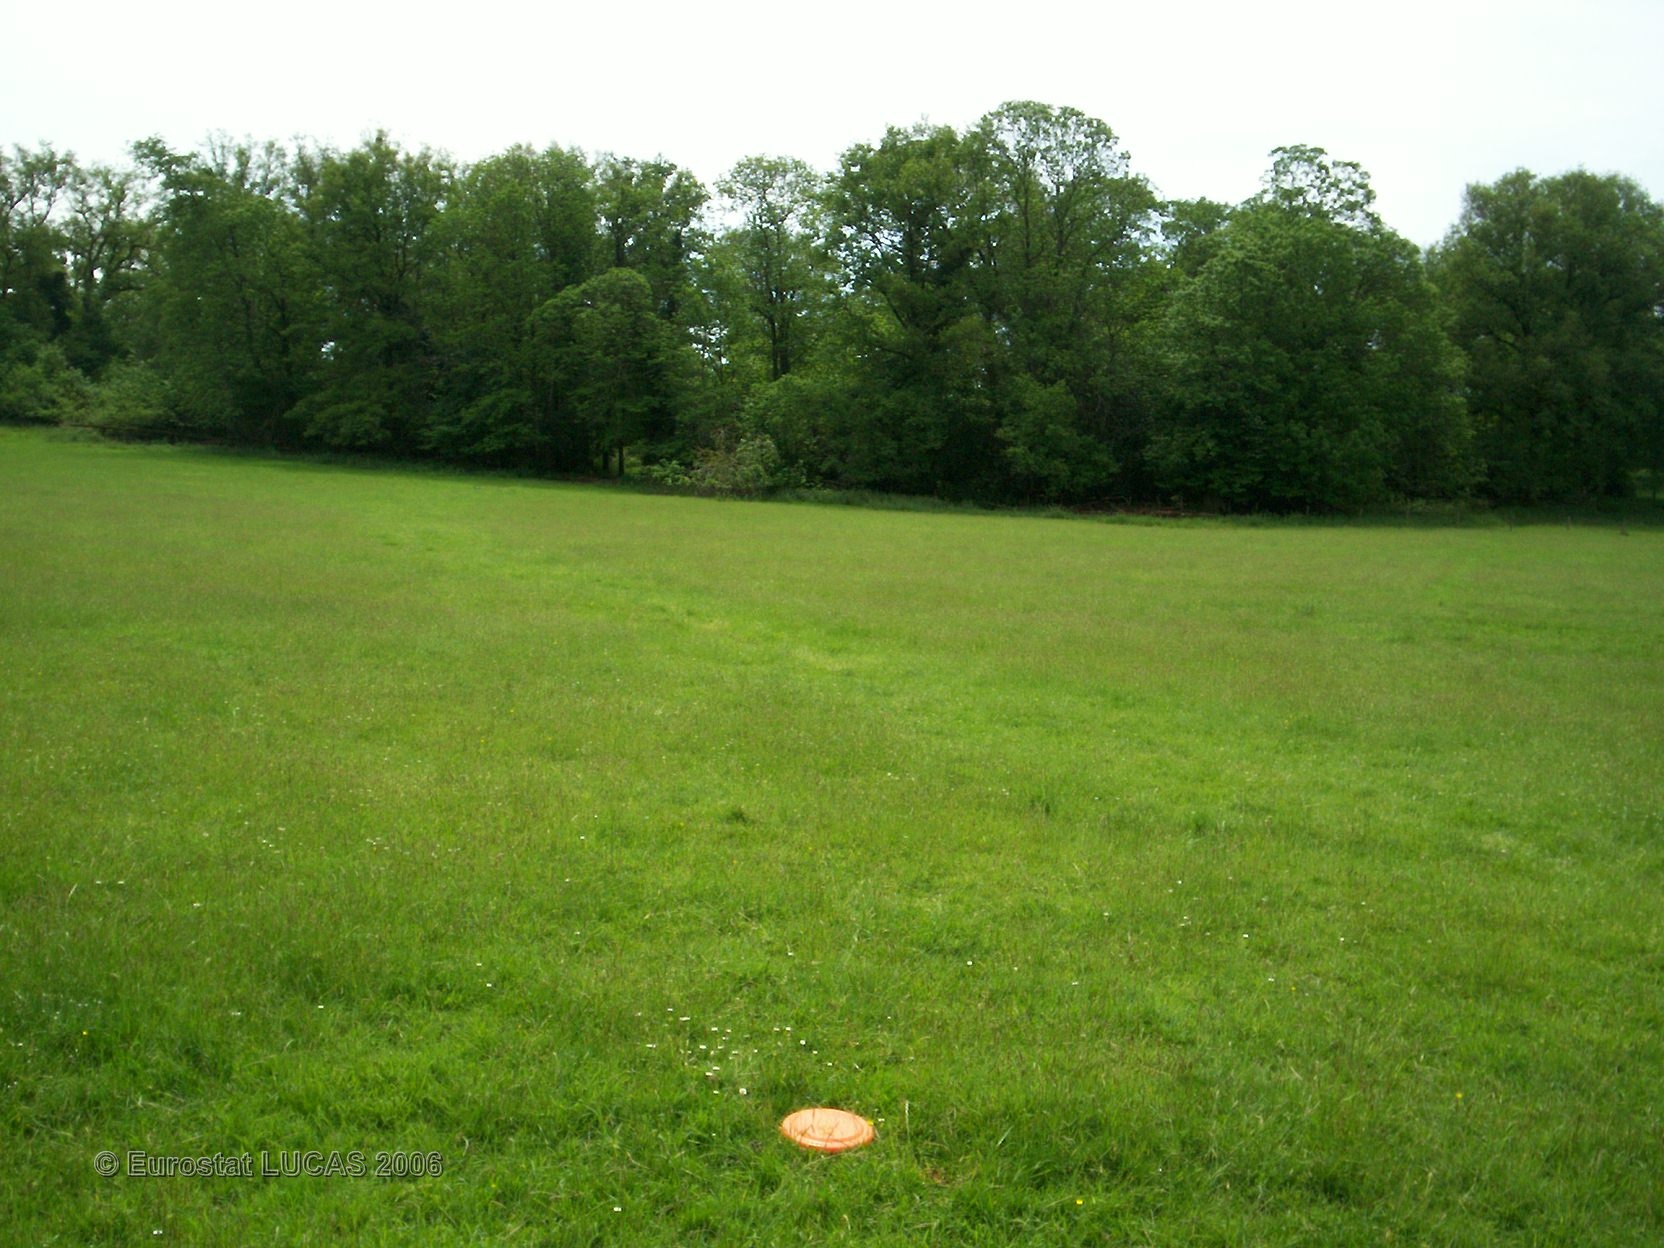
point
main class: Grassland
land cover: Grassland without tree/shrub cover
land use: Agriculture (excluding fallow land and kitchen gardens)
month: May
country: FR
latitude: 46.1622
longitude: 1.1176
